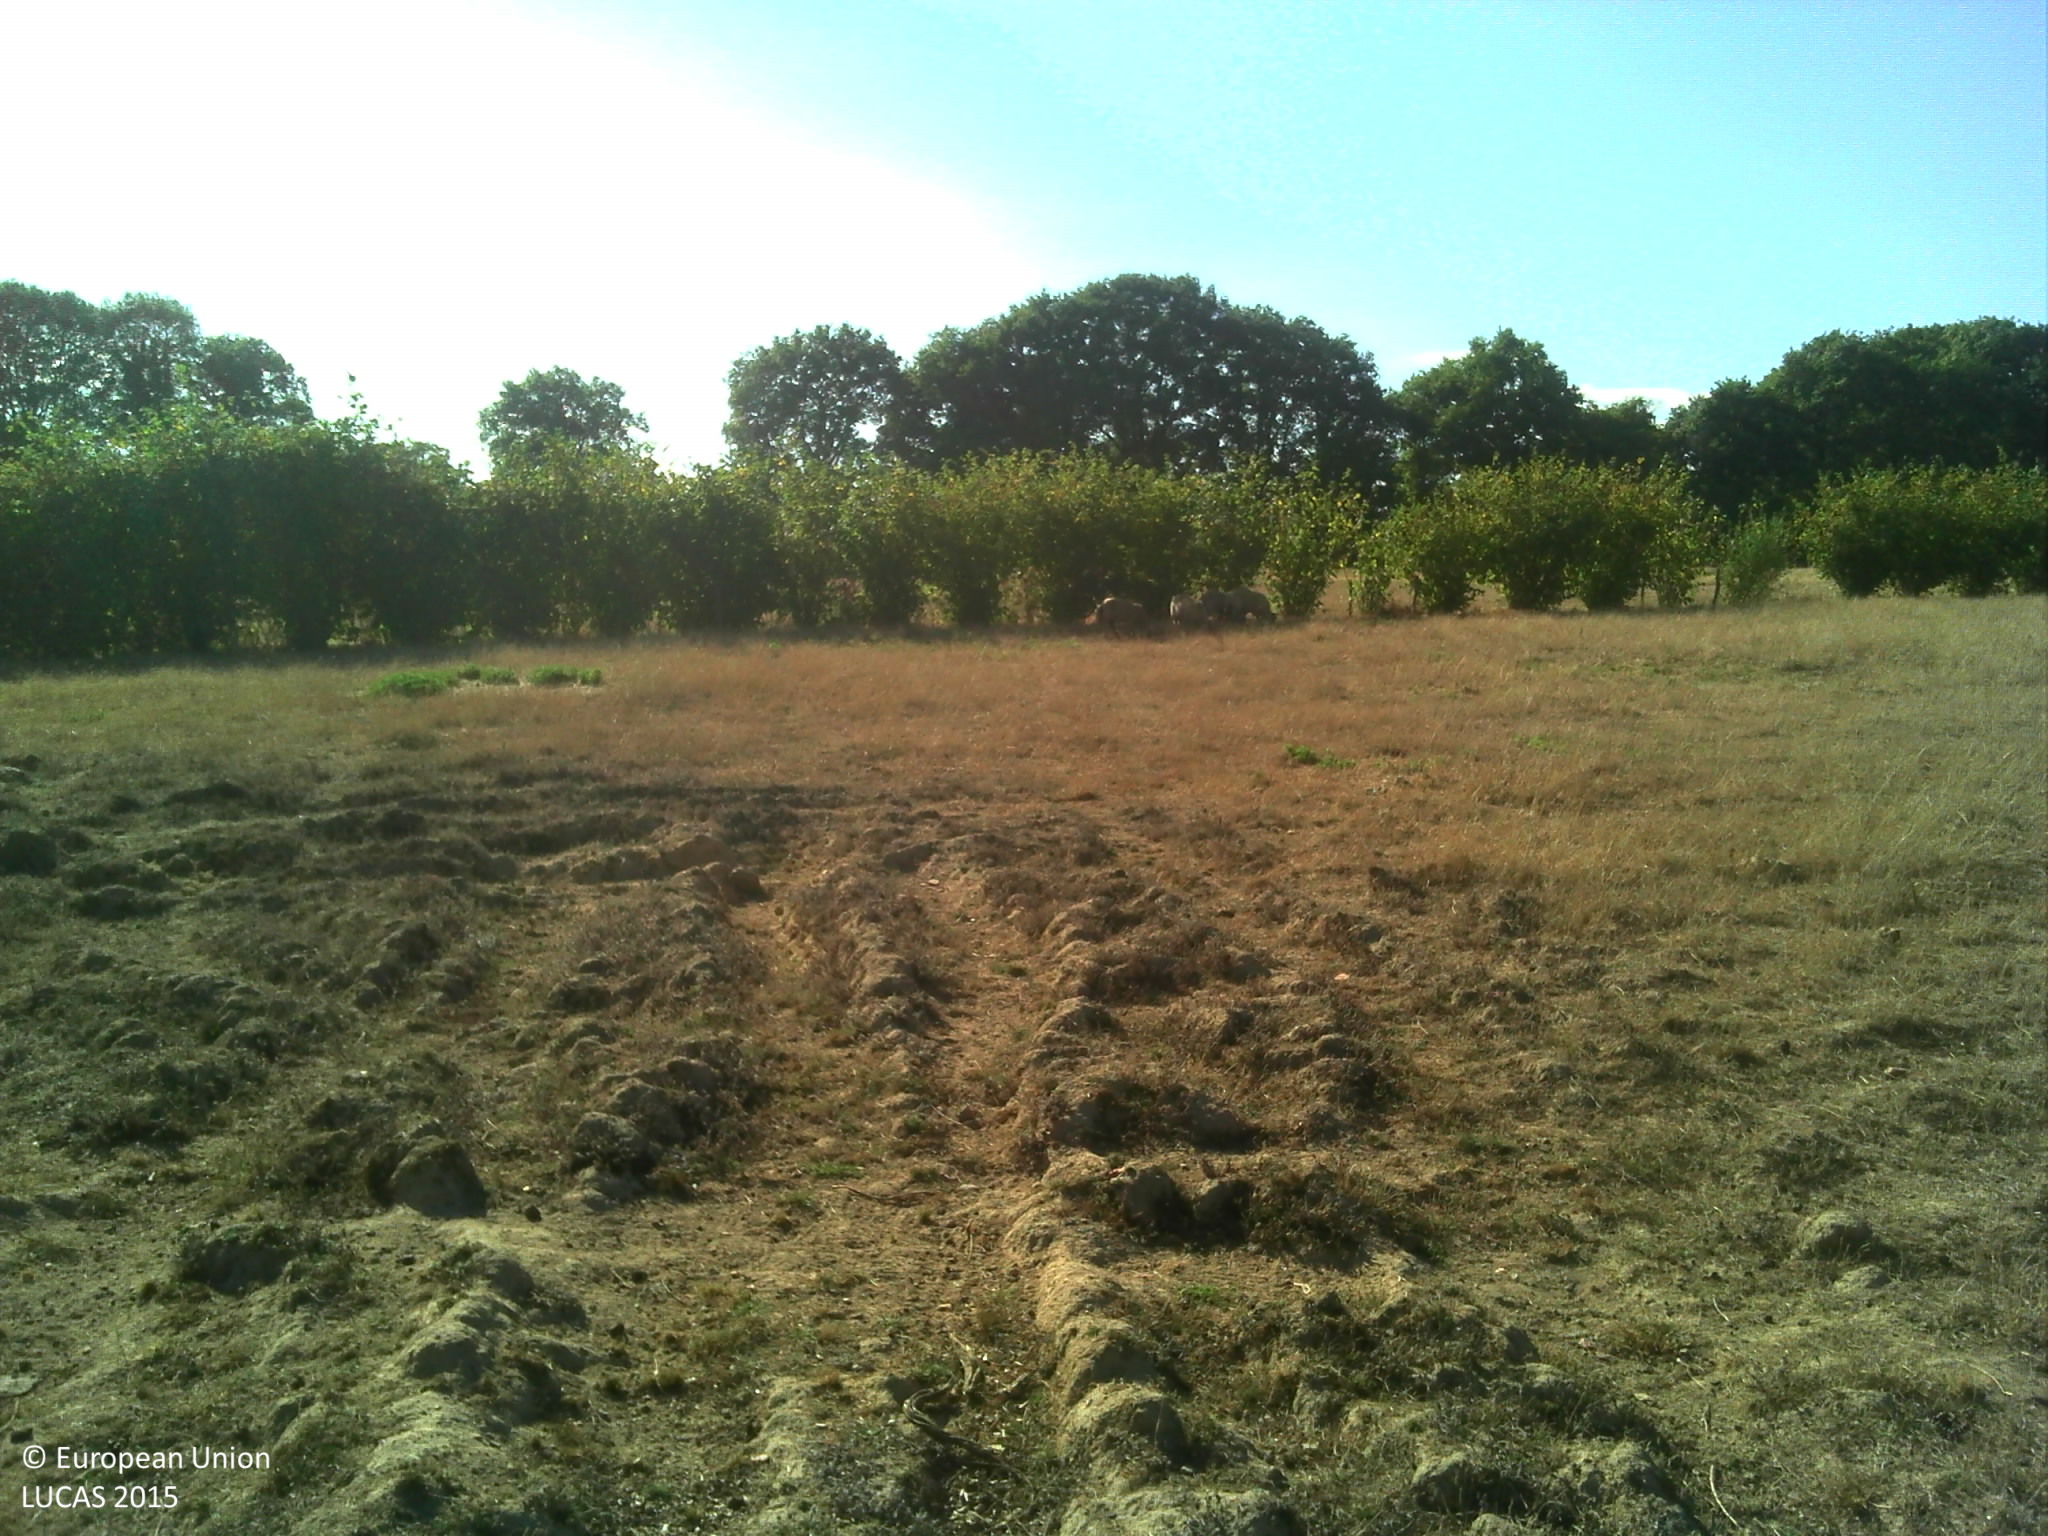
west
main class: Grassland
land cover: Grassland without tree/shrub cover
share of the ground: > 75 %
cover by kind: herbaceous plants 95 %, shrubs 5 %
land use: Residential
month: August
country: FR
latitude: 46.6767
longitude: -1.1329
